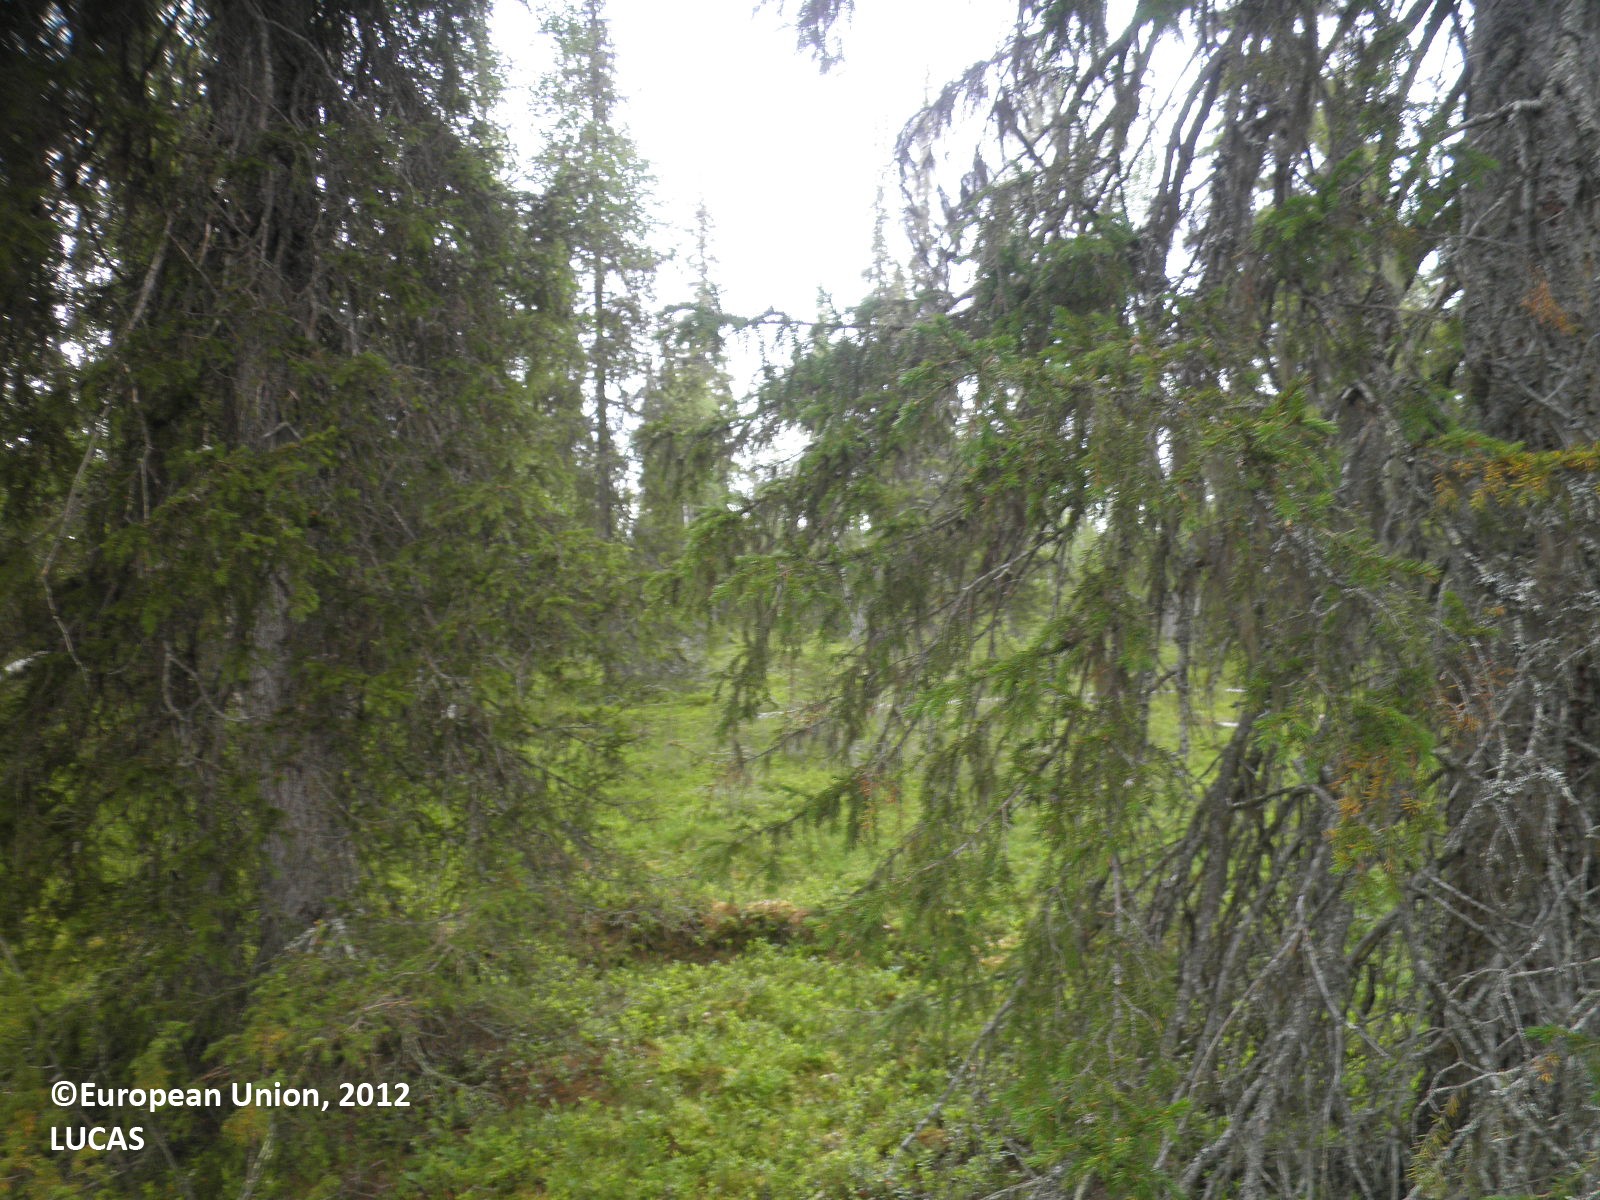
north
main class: Woodland
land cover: Spruce dominated mixed woodland
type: boreal forest
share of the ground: 50 - 75 %
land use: Forestry
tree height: > 5 m
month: July
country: FI
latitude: 67.9613
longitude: 26.1758
